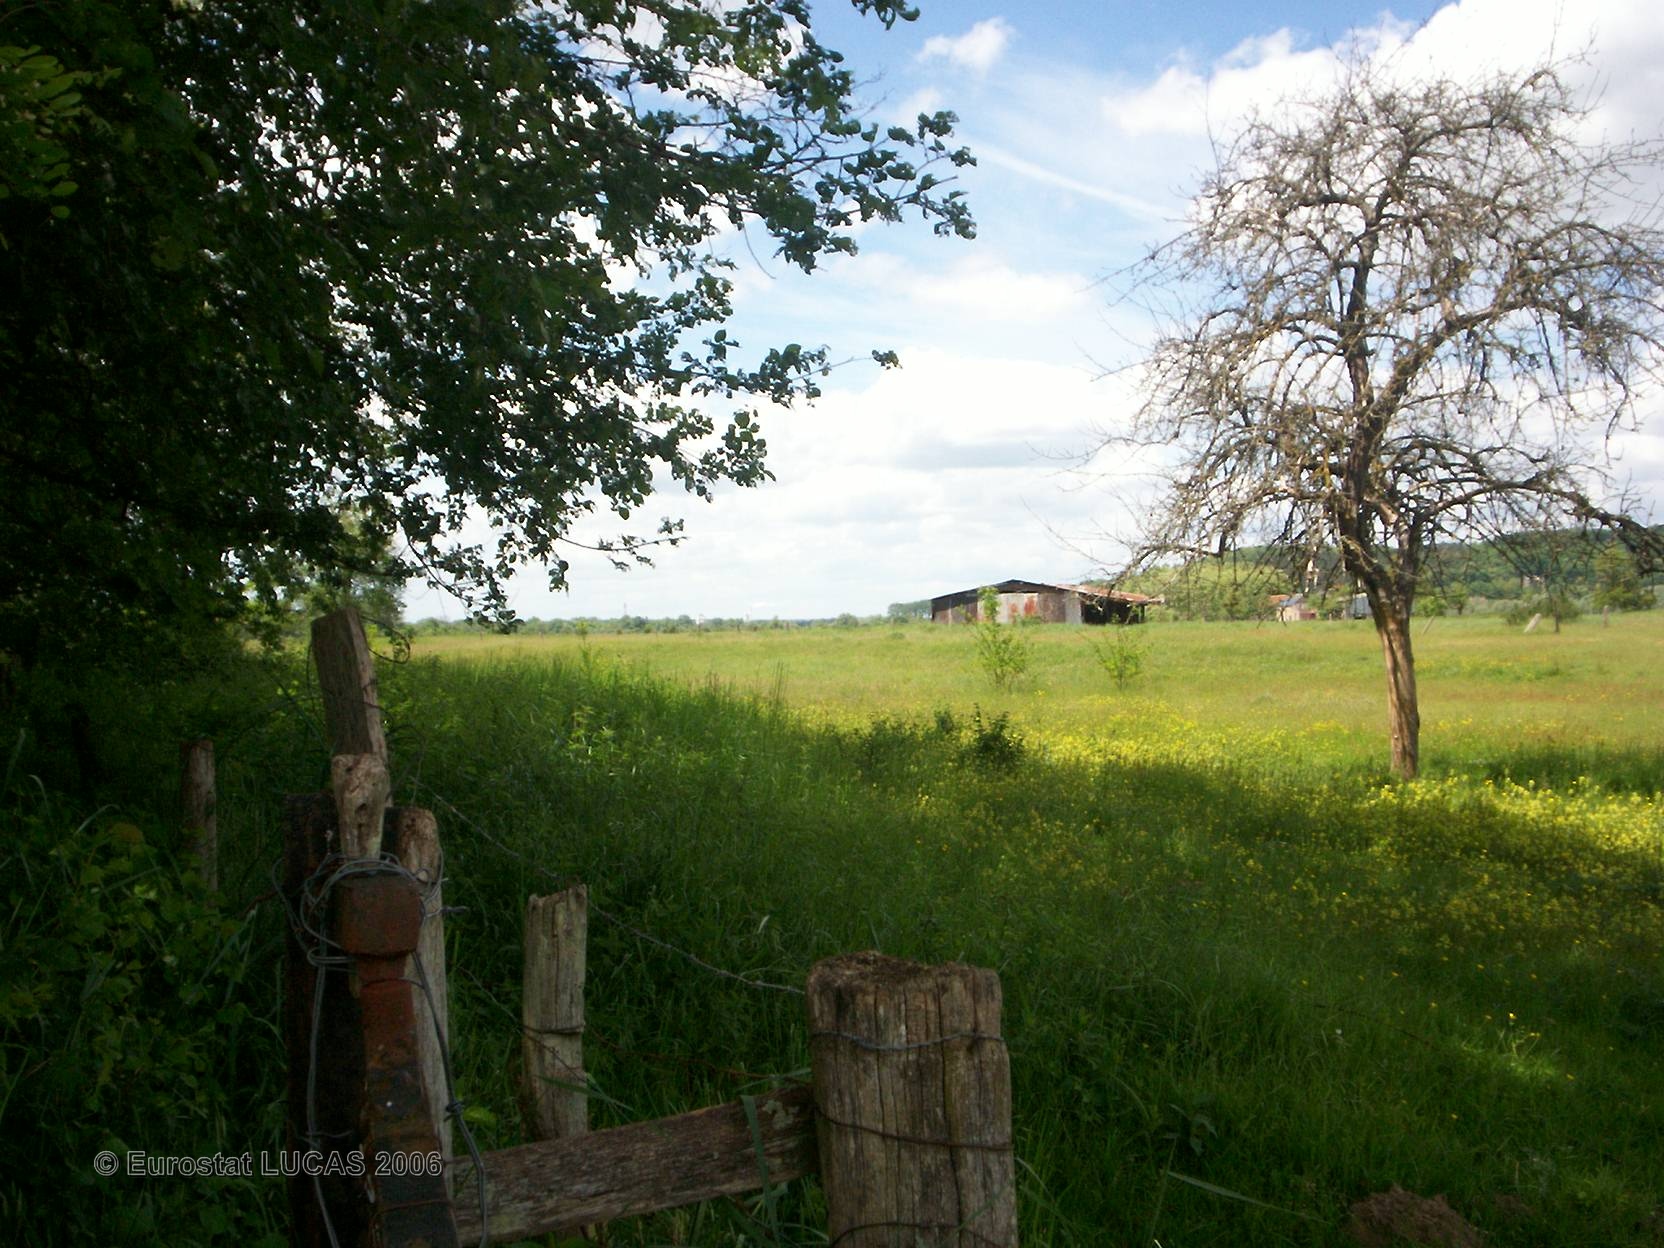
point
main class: Grassland
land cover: Grassland without tree/shrub cover
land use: Agriculture (excluding fallow land and kitchen gardens)
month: May
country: FR
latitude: 47.0473
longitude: 3.0590
